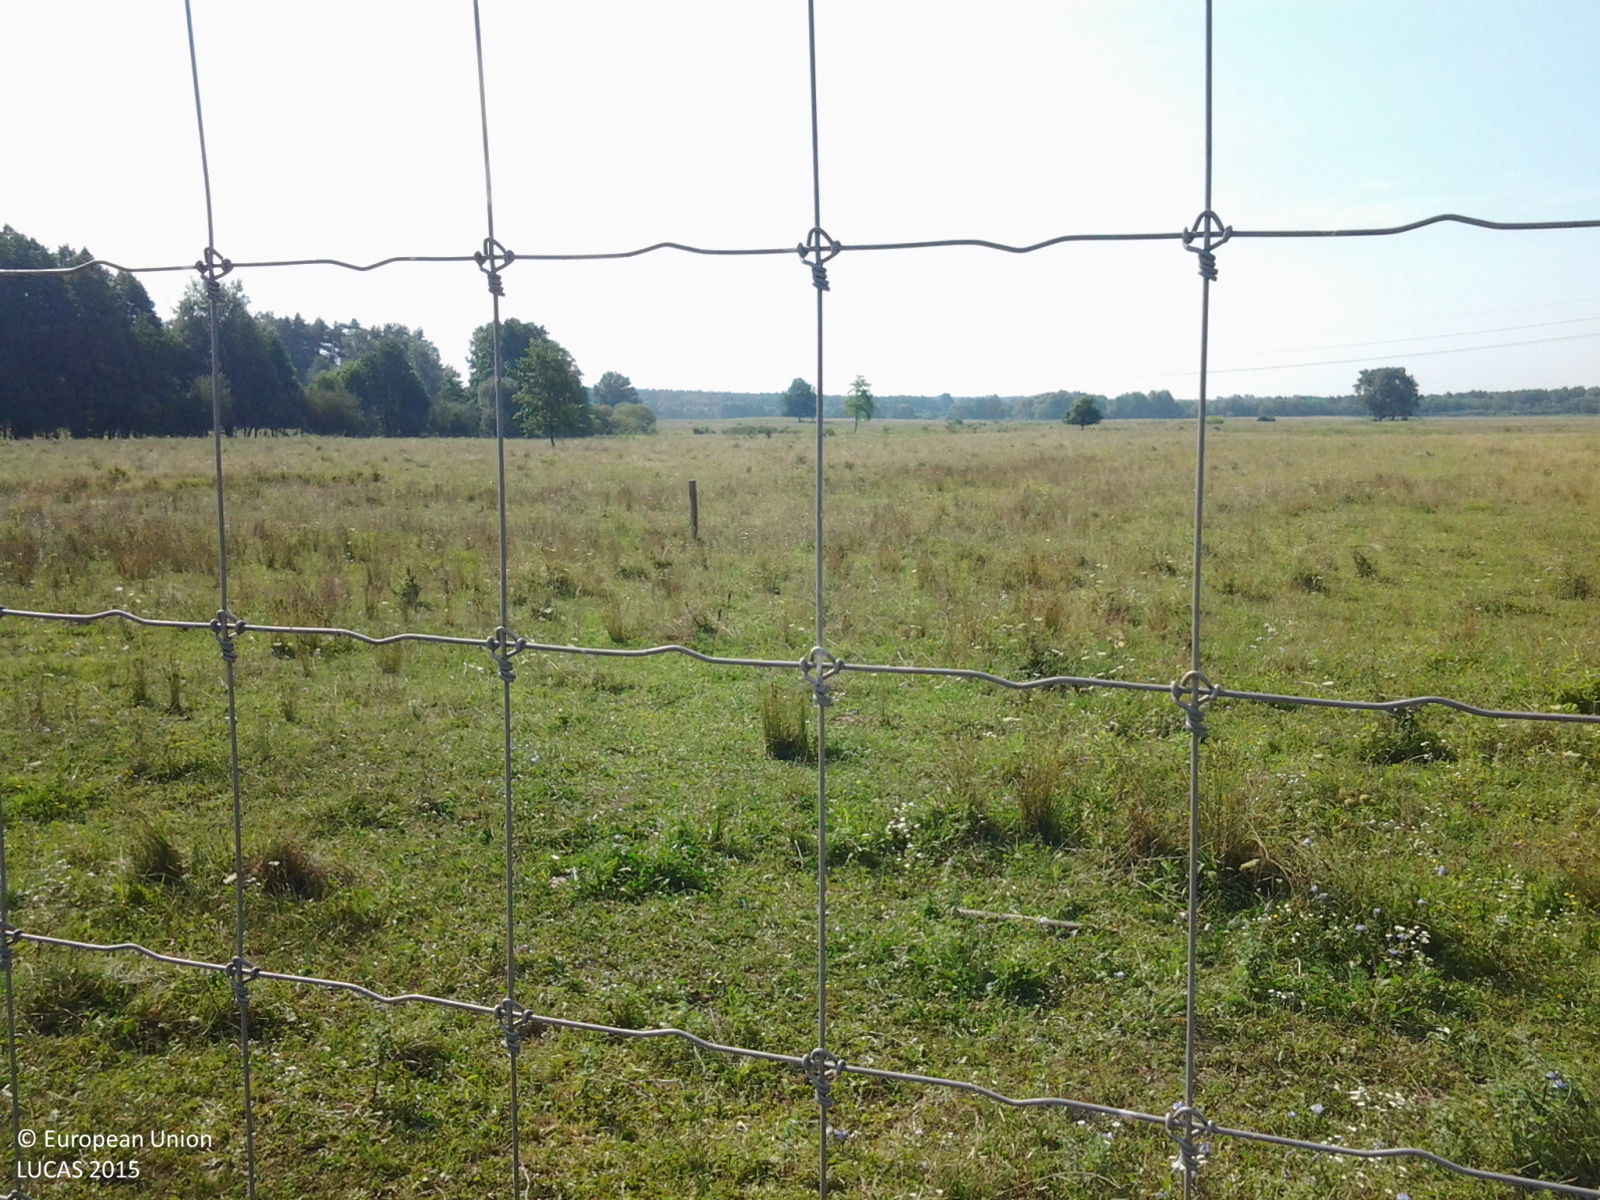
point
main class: Grassland
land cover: Grassland without tree/shrub cover
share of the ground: > 75 %
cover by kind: herbaceous plants 100 %
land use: Agriculture (excluding fallow land and kitchen gardens)
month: August
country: HU
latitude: 46.5055
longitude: 17.2102
